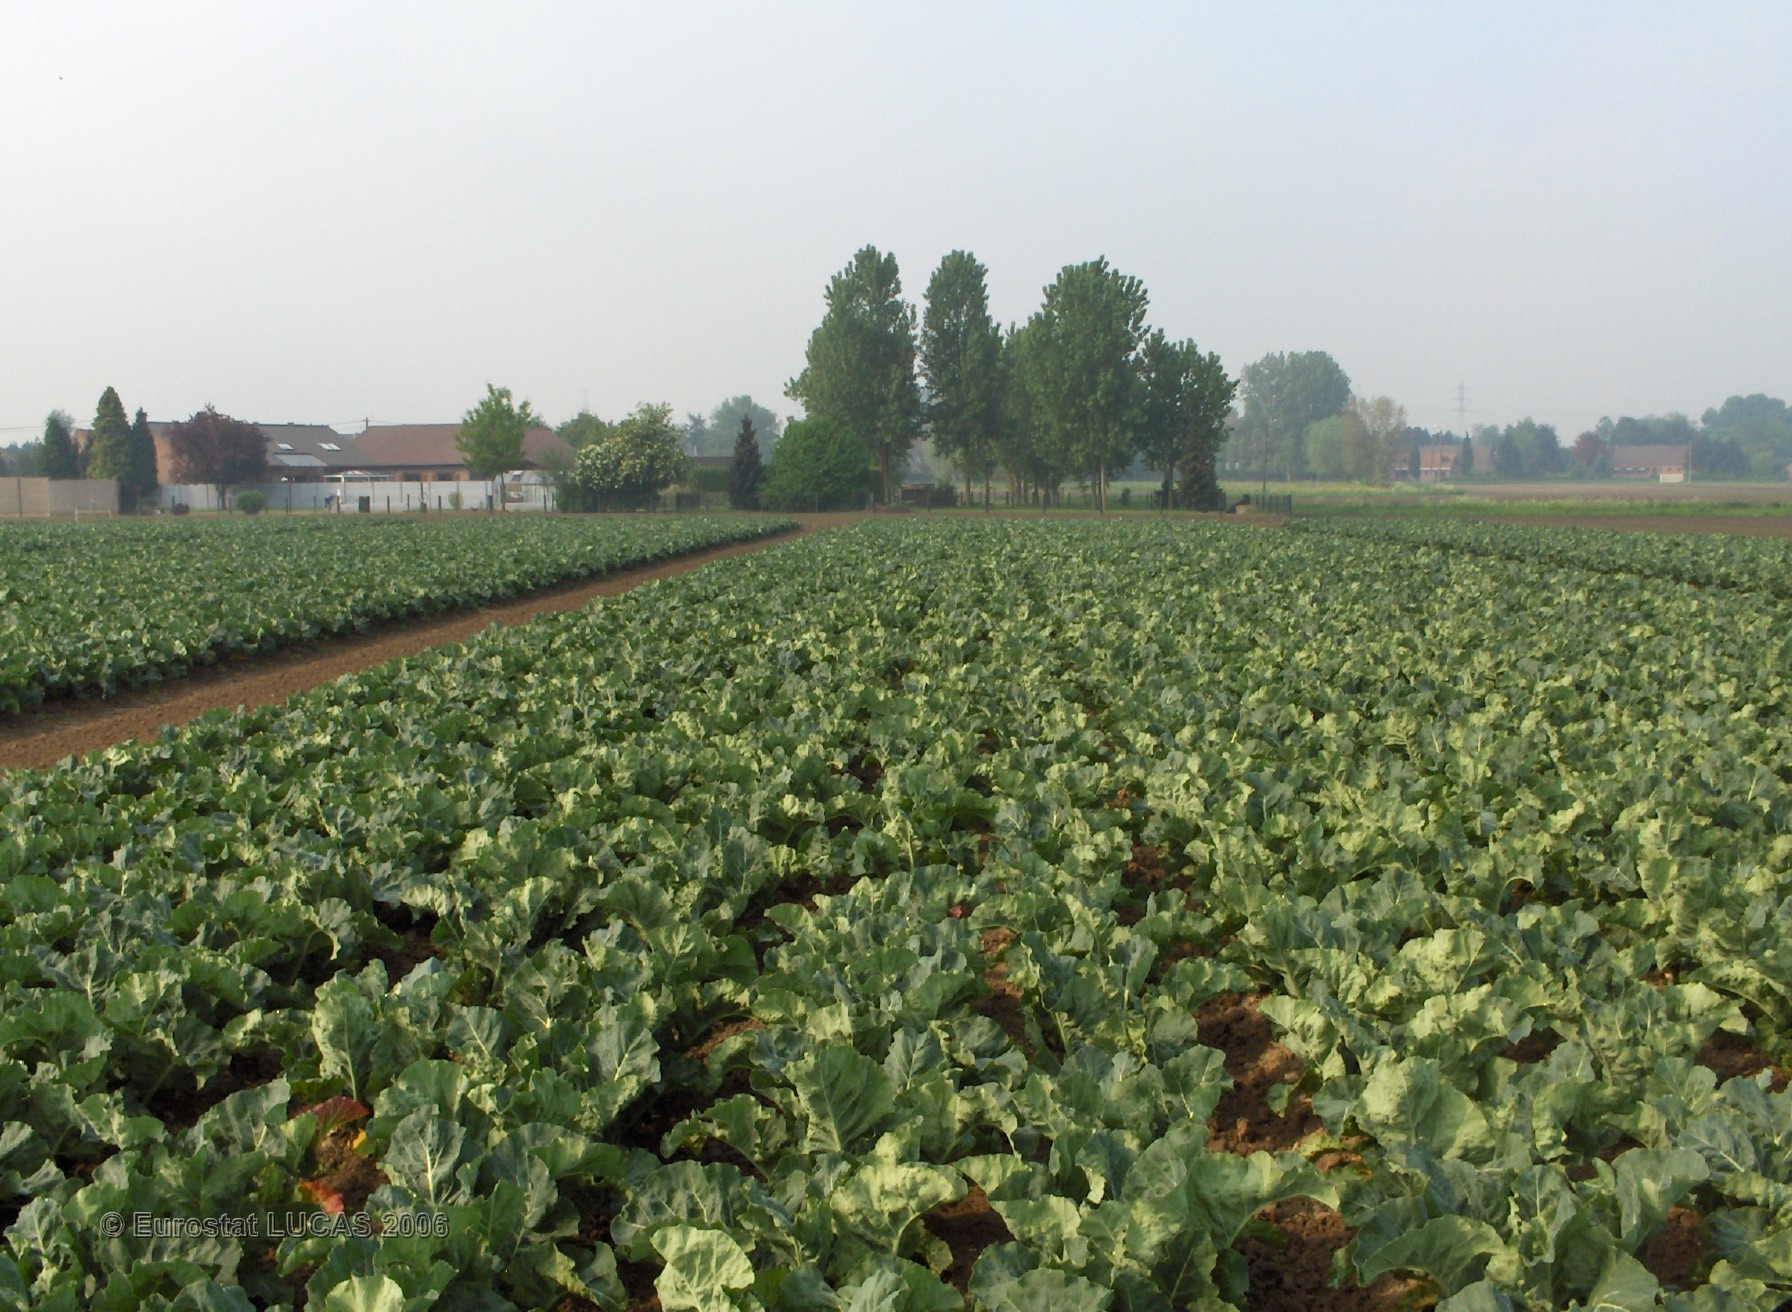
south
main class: Cropland
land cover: Other fresh vegetables
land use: Agriculture (excluding fallow land and kitchen gardens)
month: May
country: BE
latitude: 51.0210
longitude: 4.4214
